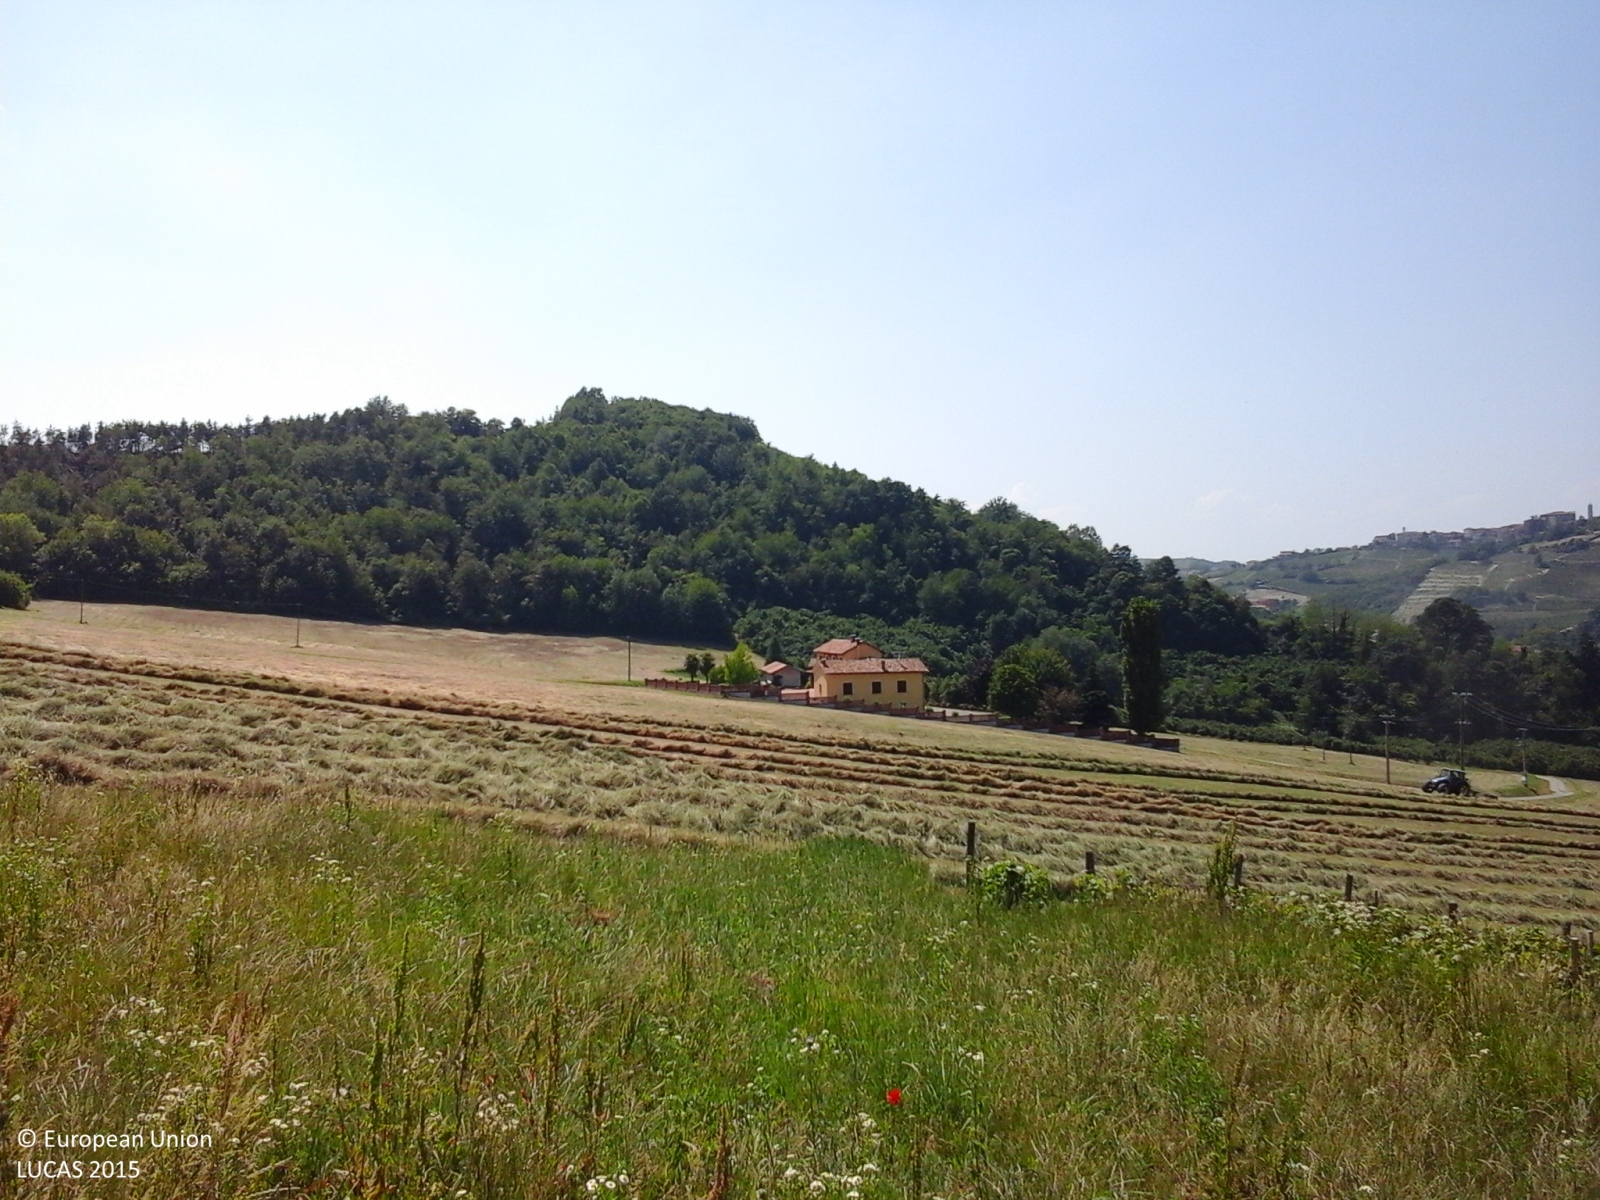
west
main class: Grassland
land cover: Spontaneously vegetated surfaces
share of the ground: > 75 %
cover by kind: herbaceous plants 100 %
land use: Fallow land
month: June
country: IT
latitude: 44.6772
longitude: 8.1745
